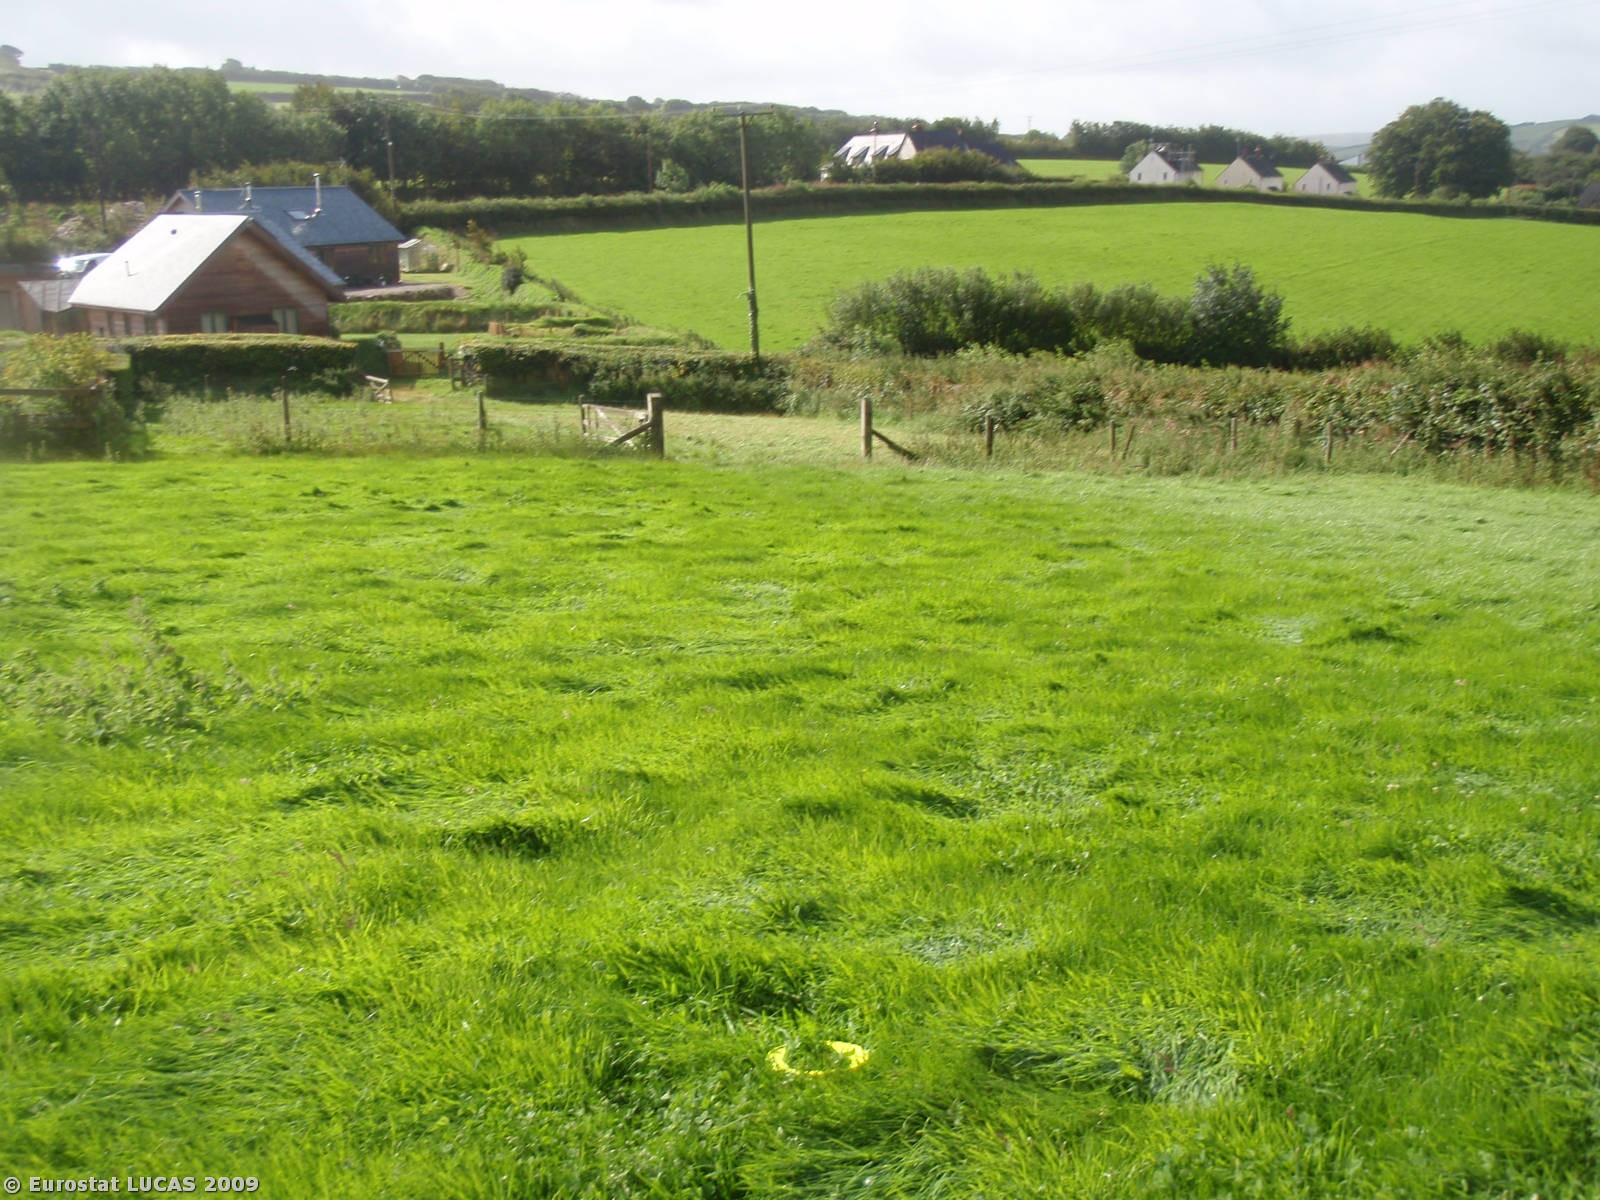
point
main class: Grassland
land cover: Grassland without tree/shrub cover
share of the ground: > 75 %
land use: Agriculture (excluding fallow land and kitchen gardens)
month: August
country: GB
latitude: 51.1415
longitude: -3.5350
